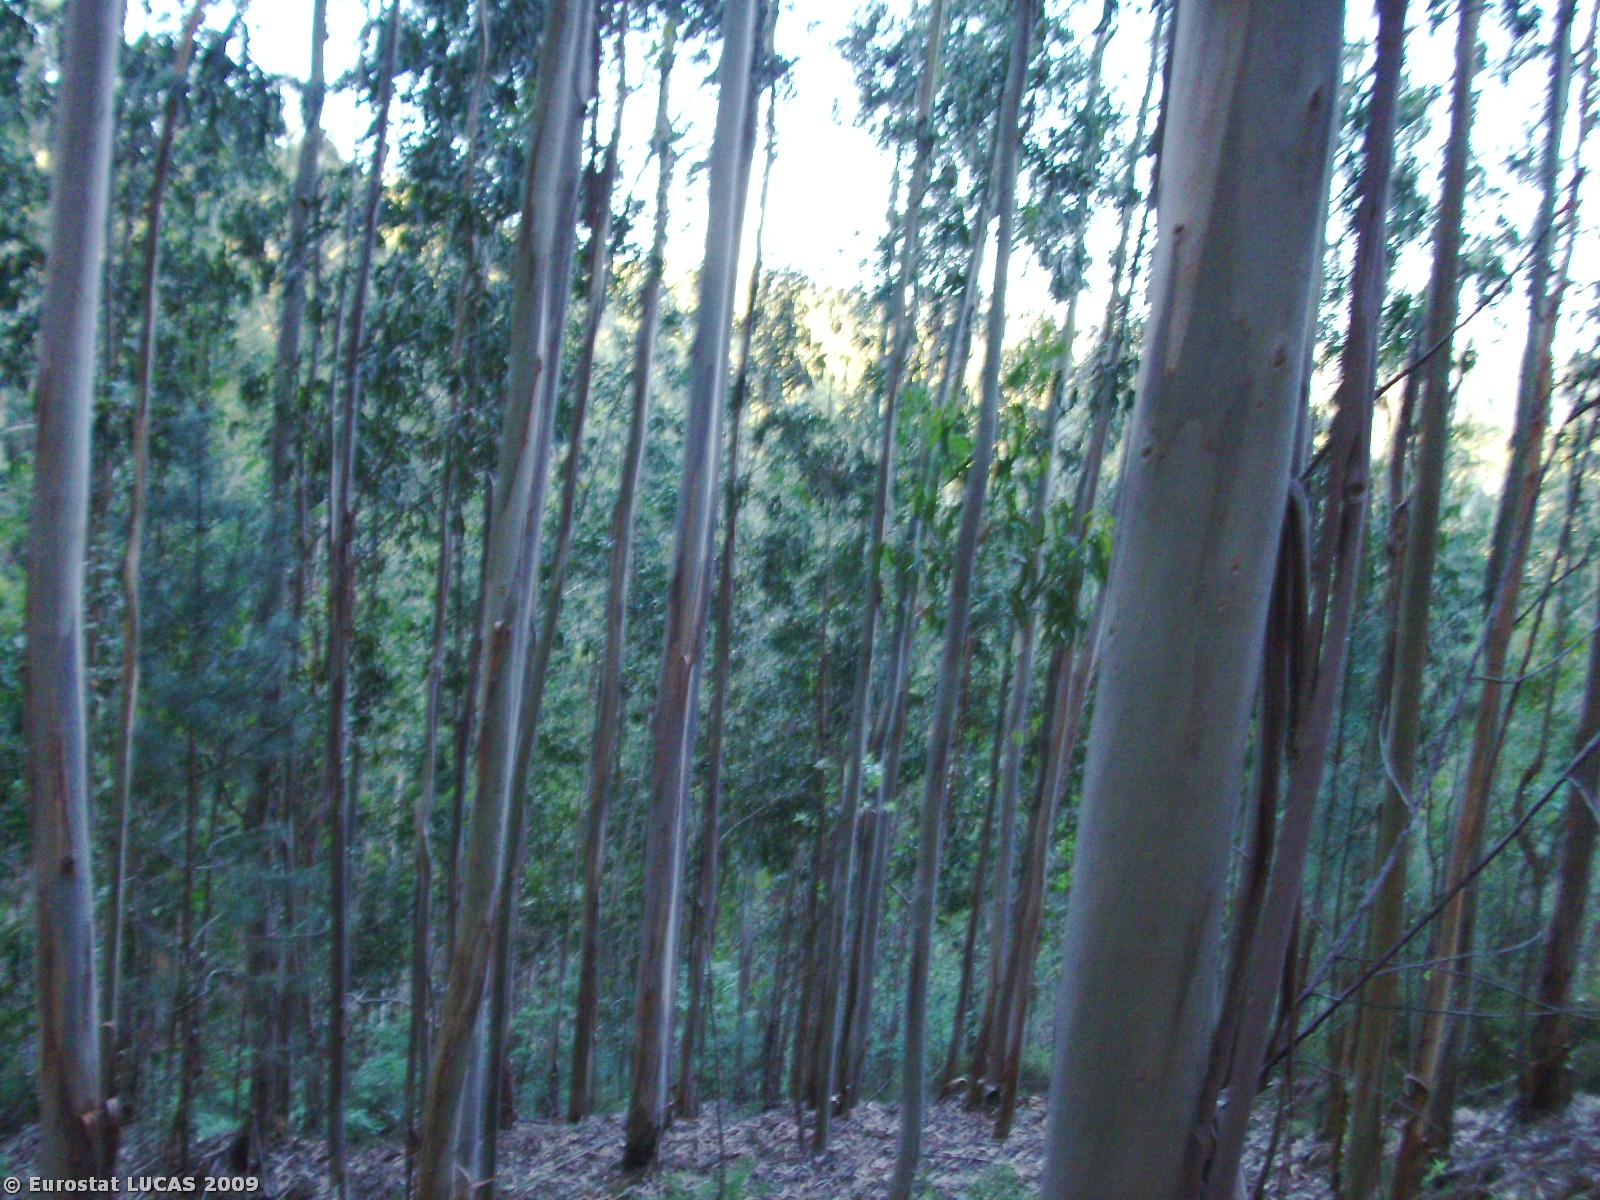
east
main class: Woodland
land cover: Broadleaved woodland
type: plantations and self-sown exotic forest
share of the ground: > 75 %
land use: Forestry
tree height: > 5 m
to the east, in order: Broadleaved woodland; Tracks; Broadleaved woodland; Tracks; Groves; Rivers and streams; Groves; Tracks; Broadleaved woodland
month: May
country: PT
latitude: 40.7757
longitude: -8.4471
